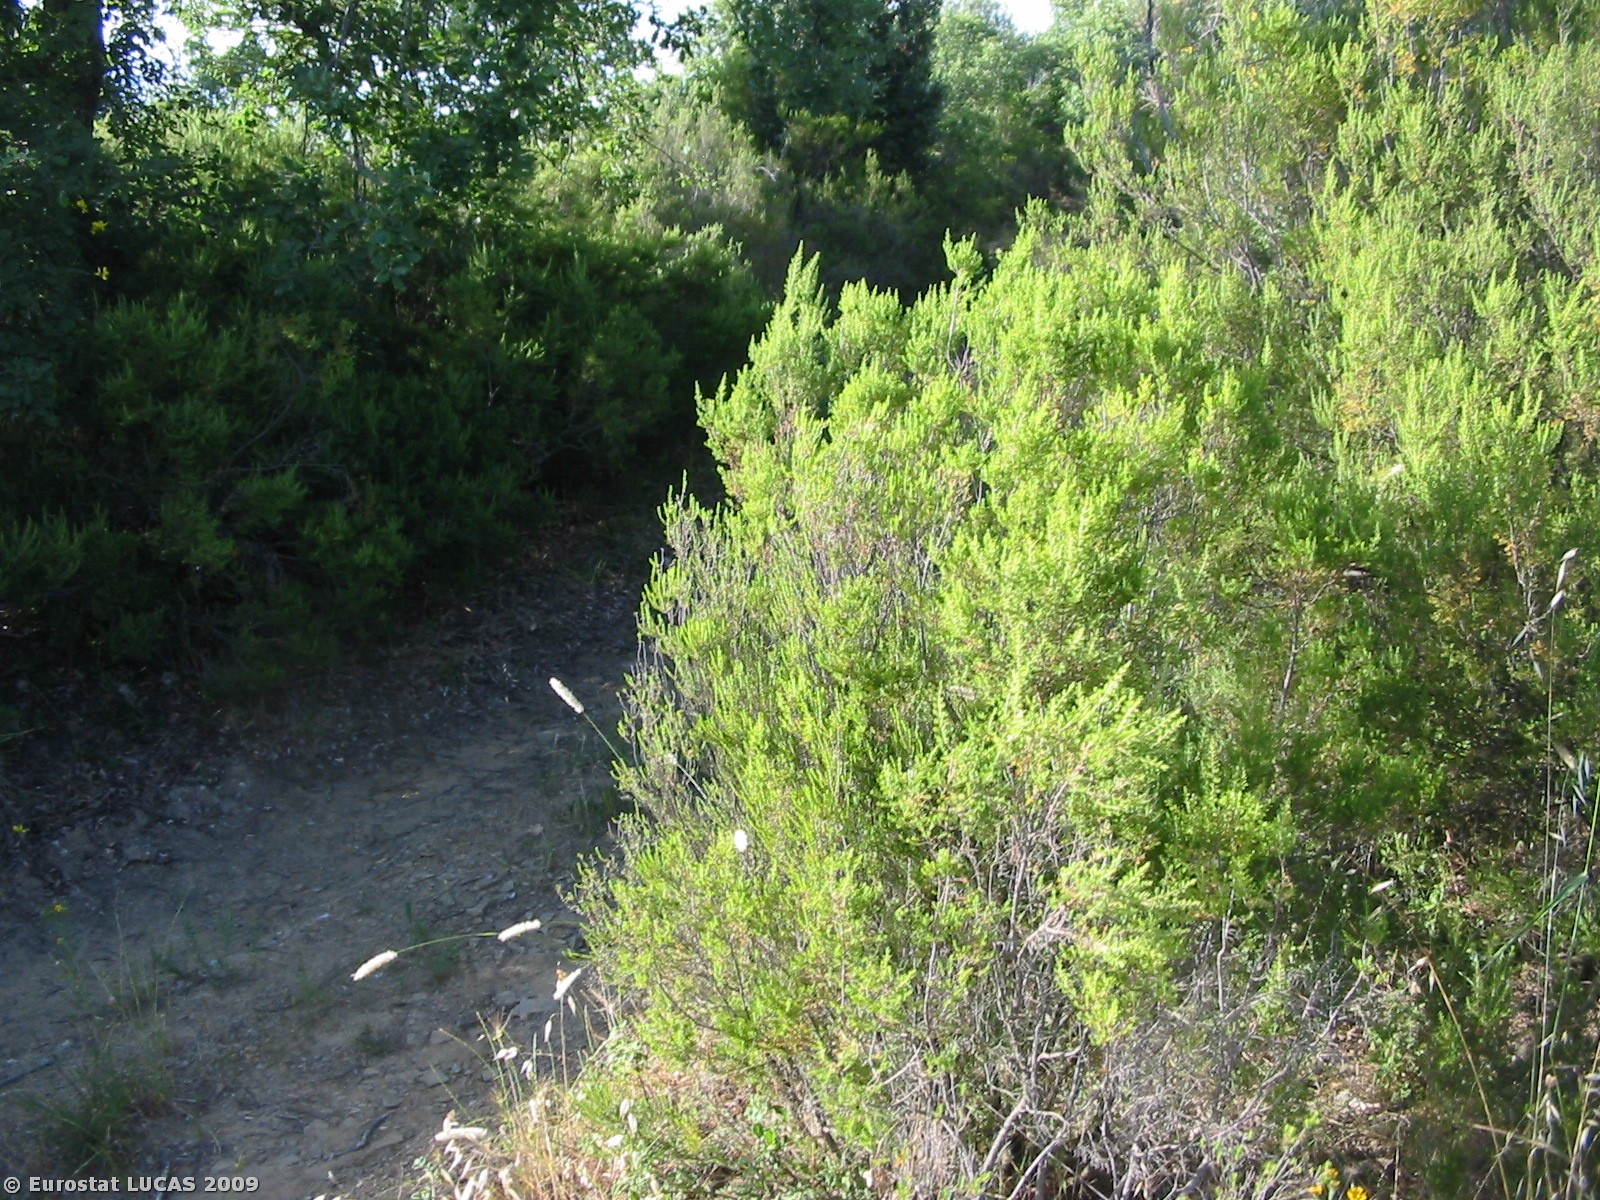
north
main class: Shrubland
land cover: Shrubland with sparse tree cover
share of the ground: > 75 %
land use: Unused
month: June
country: IT
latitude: 43.2721
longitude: 11.6831
